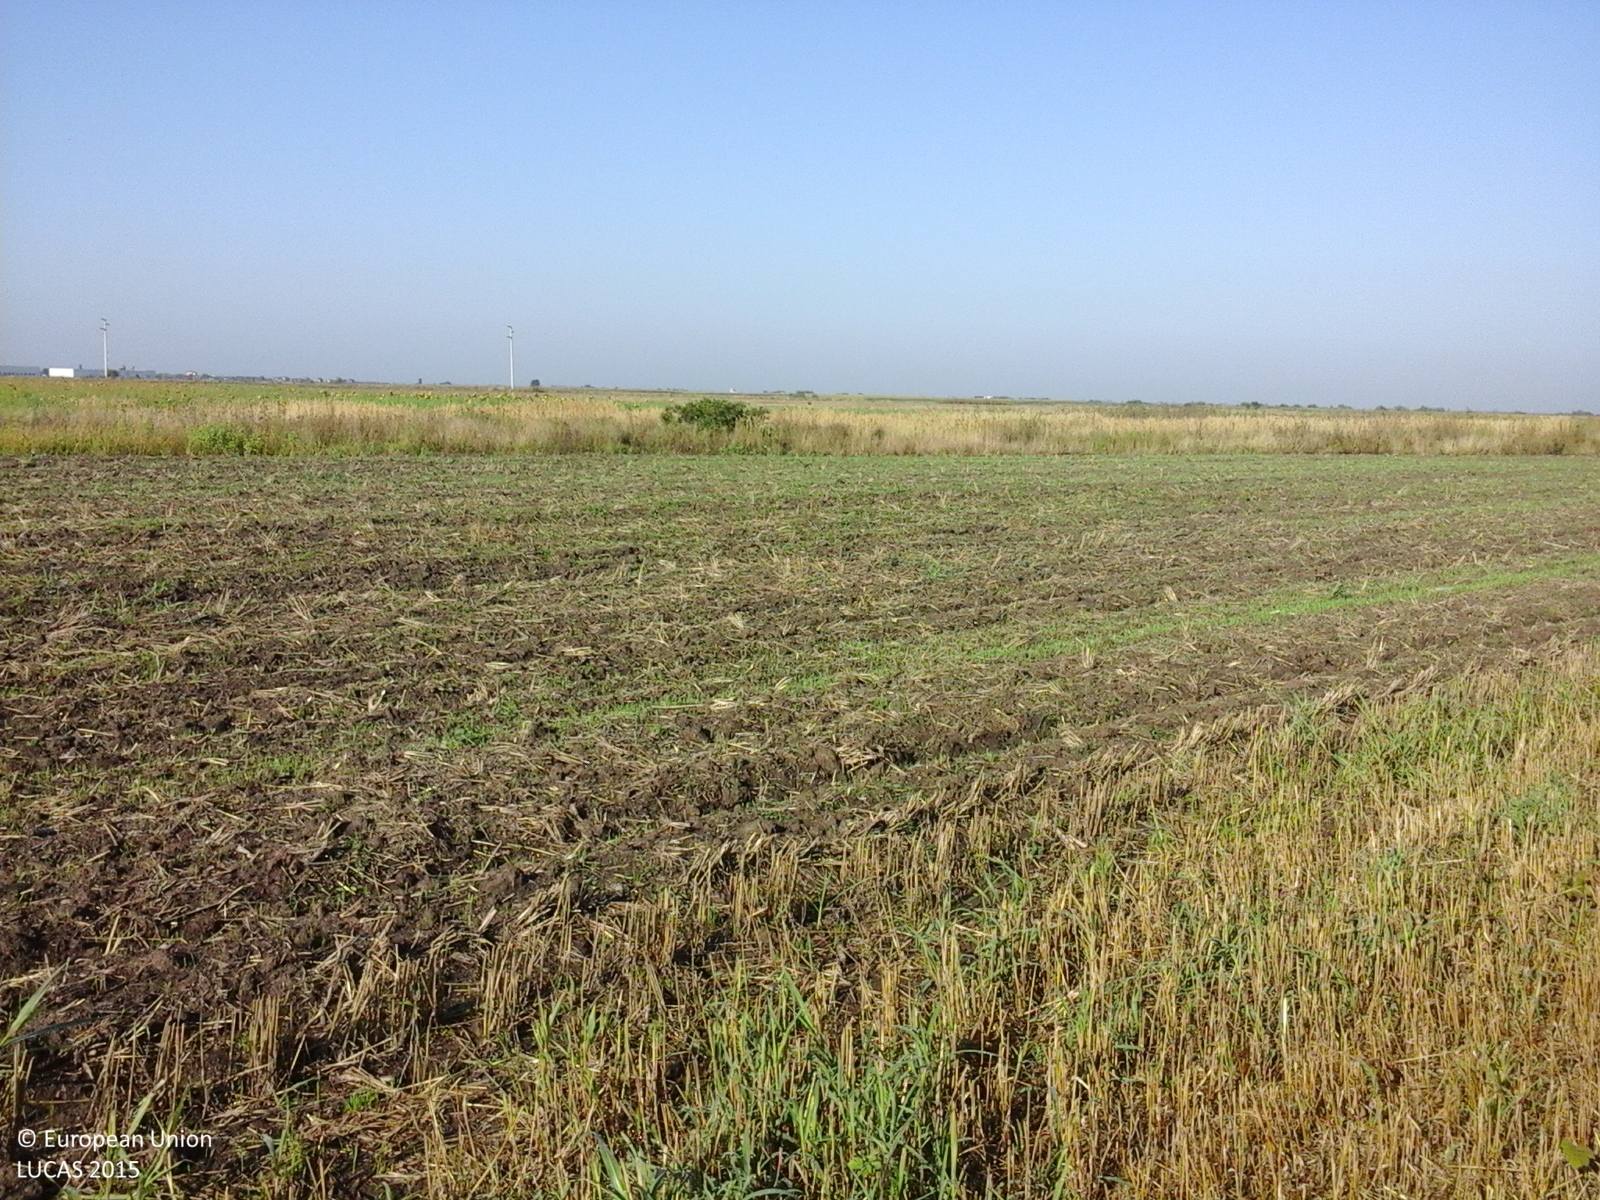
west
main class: Cropland
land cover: Durum wheat
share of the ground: 25 - 50 %
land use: Agriculture (excluding fallow land and kitchen gardens)
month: August
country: RO
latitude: 45.7865
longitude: 21.1305
